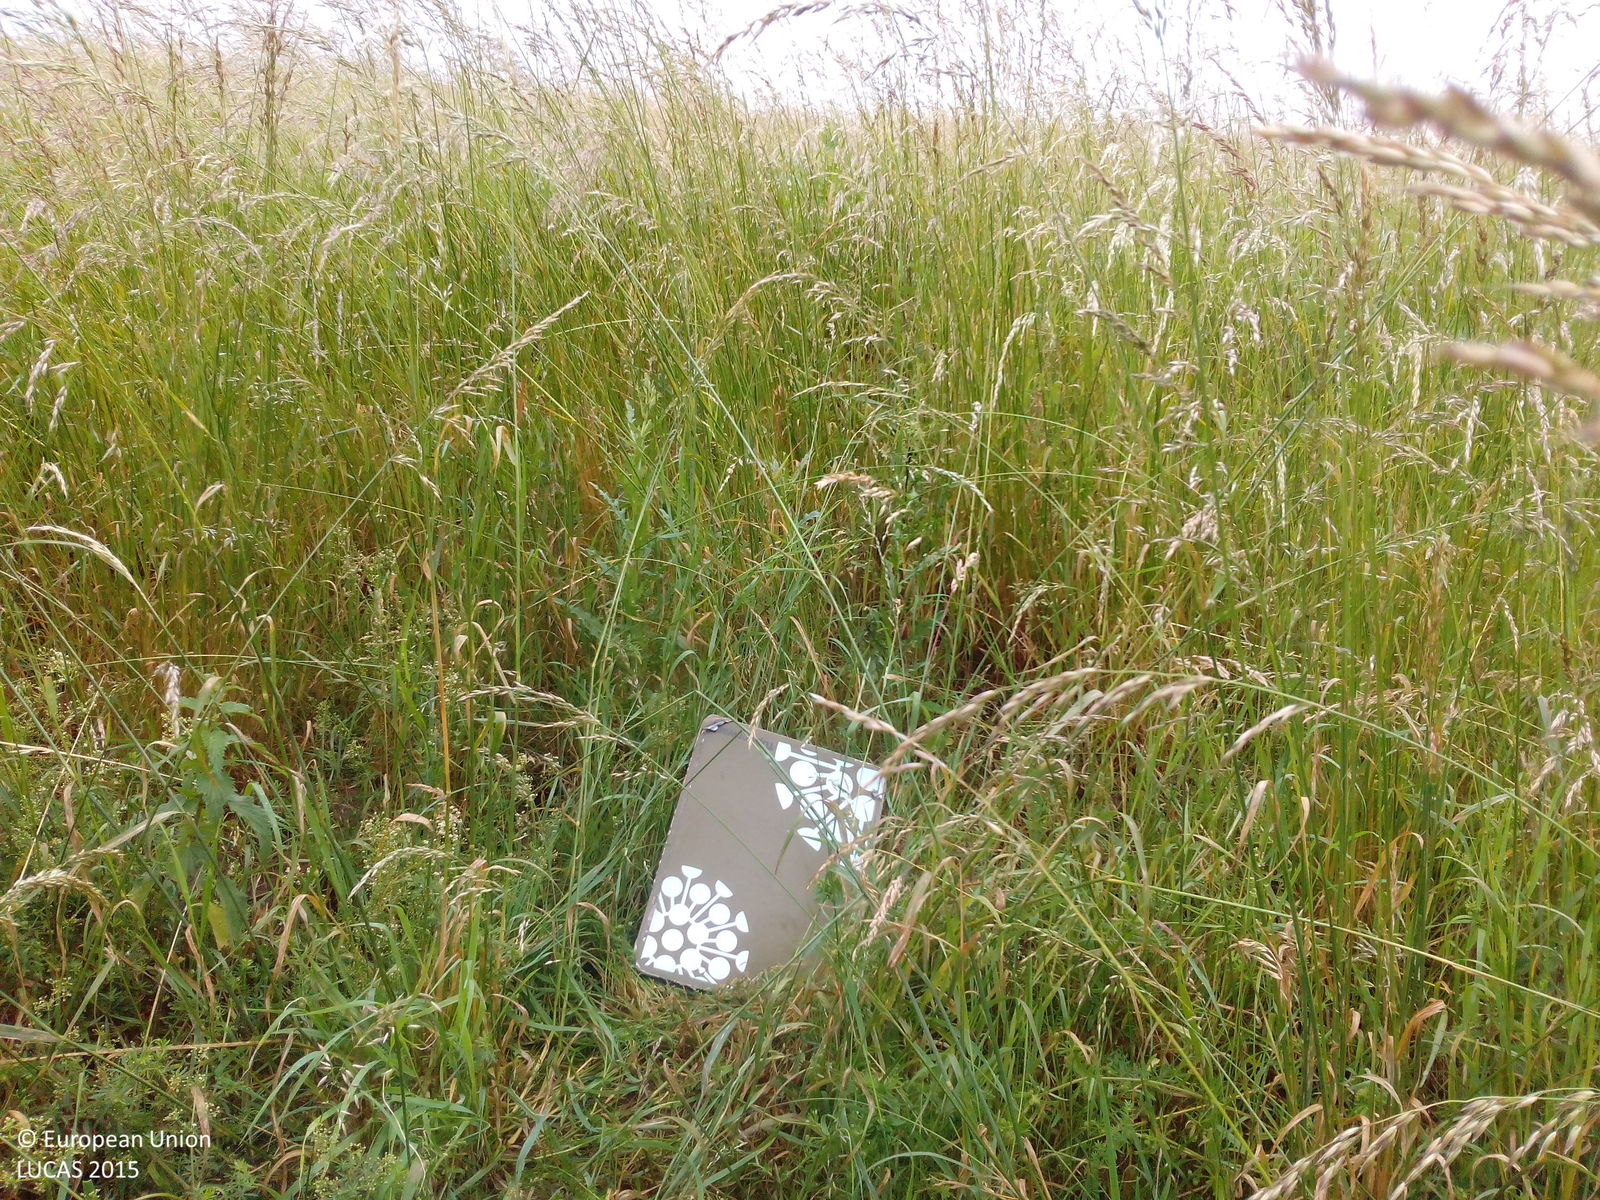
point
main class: Grassland
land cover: Grassland without tree/shrub cover
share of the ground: > 75 %
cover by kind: herbaceous plants 100 %
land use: Waste treatment
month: June
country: DE
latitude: 50.7125
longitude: 11.6000
